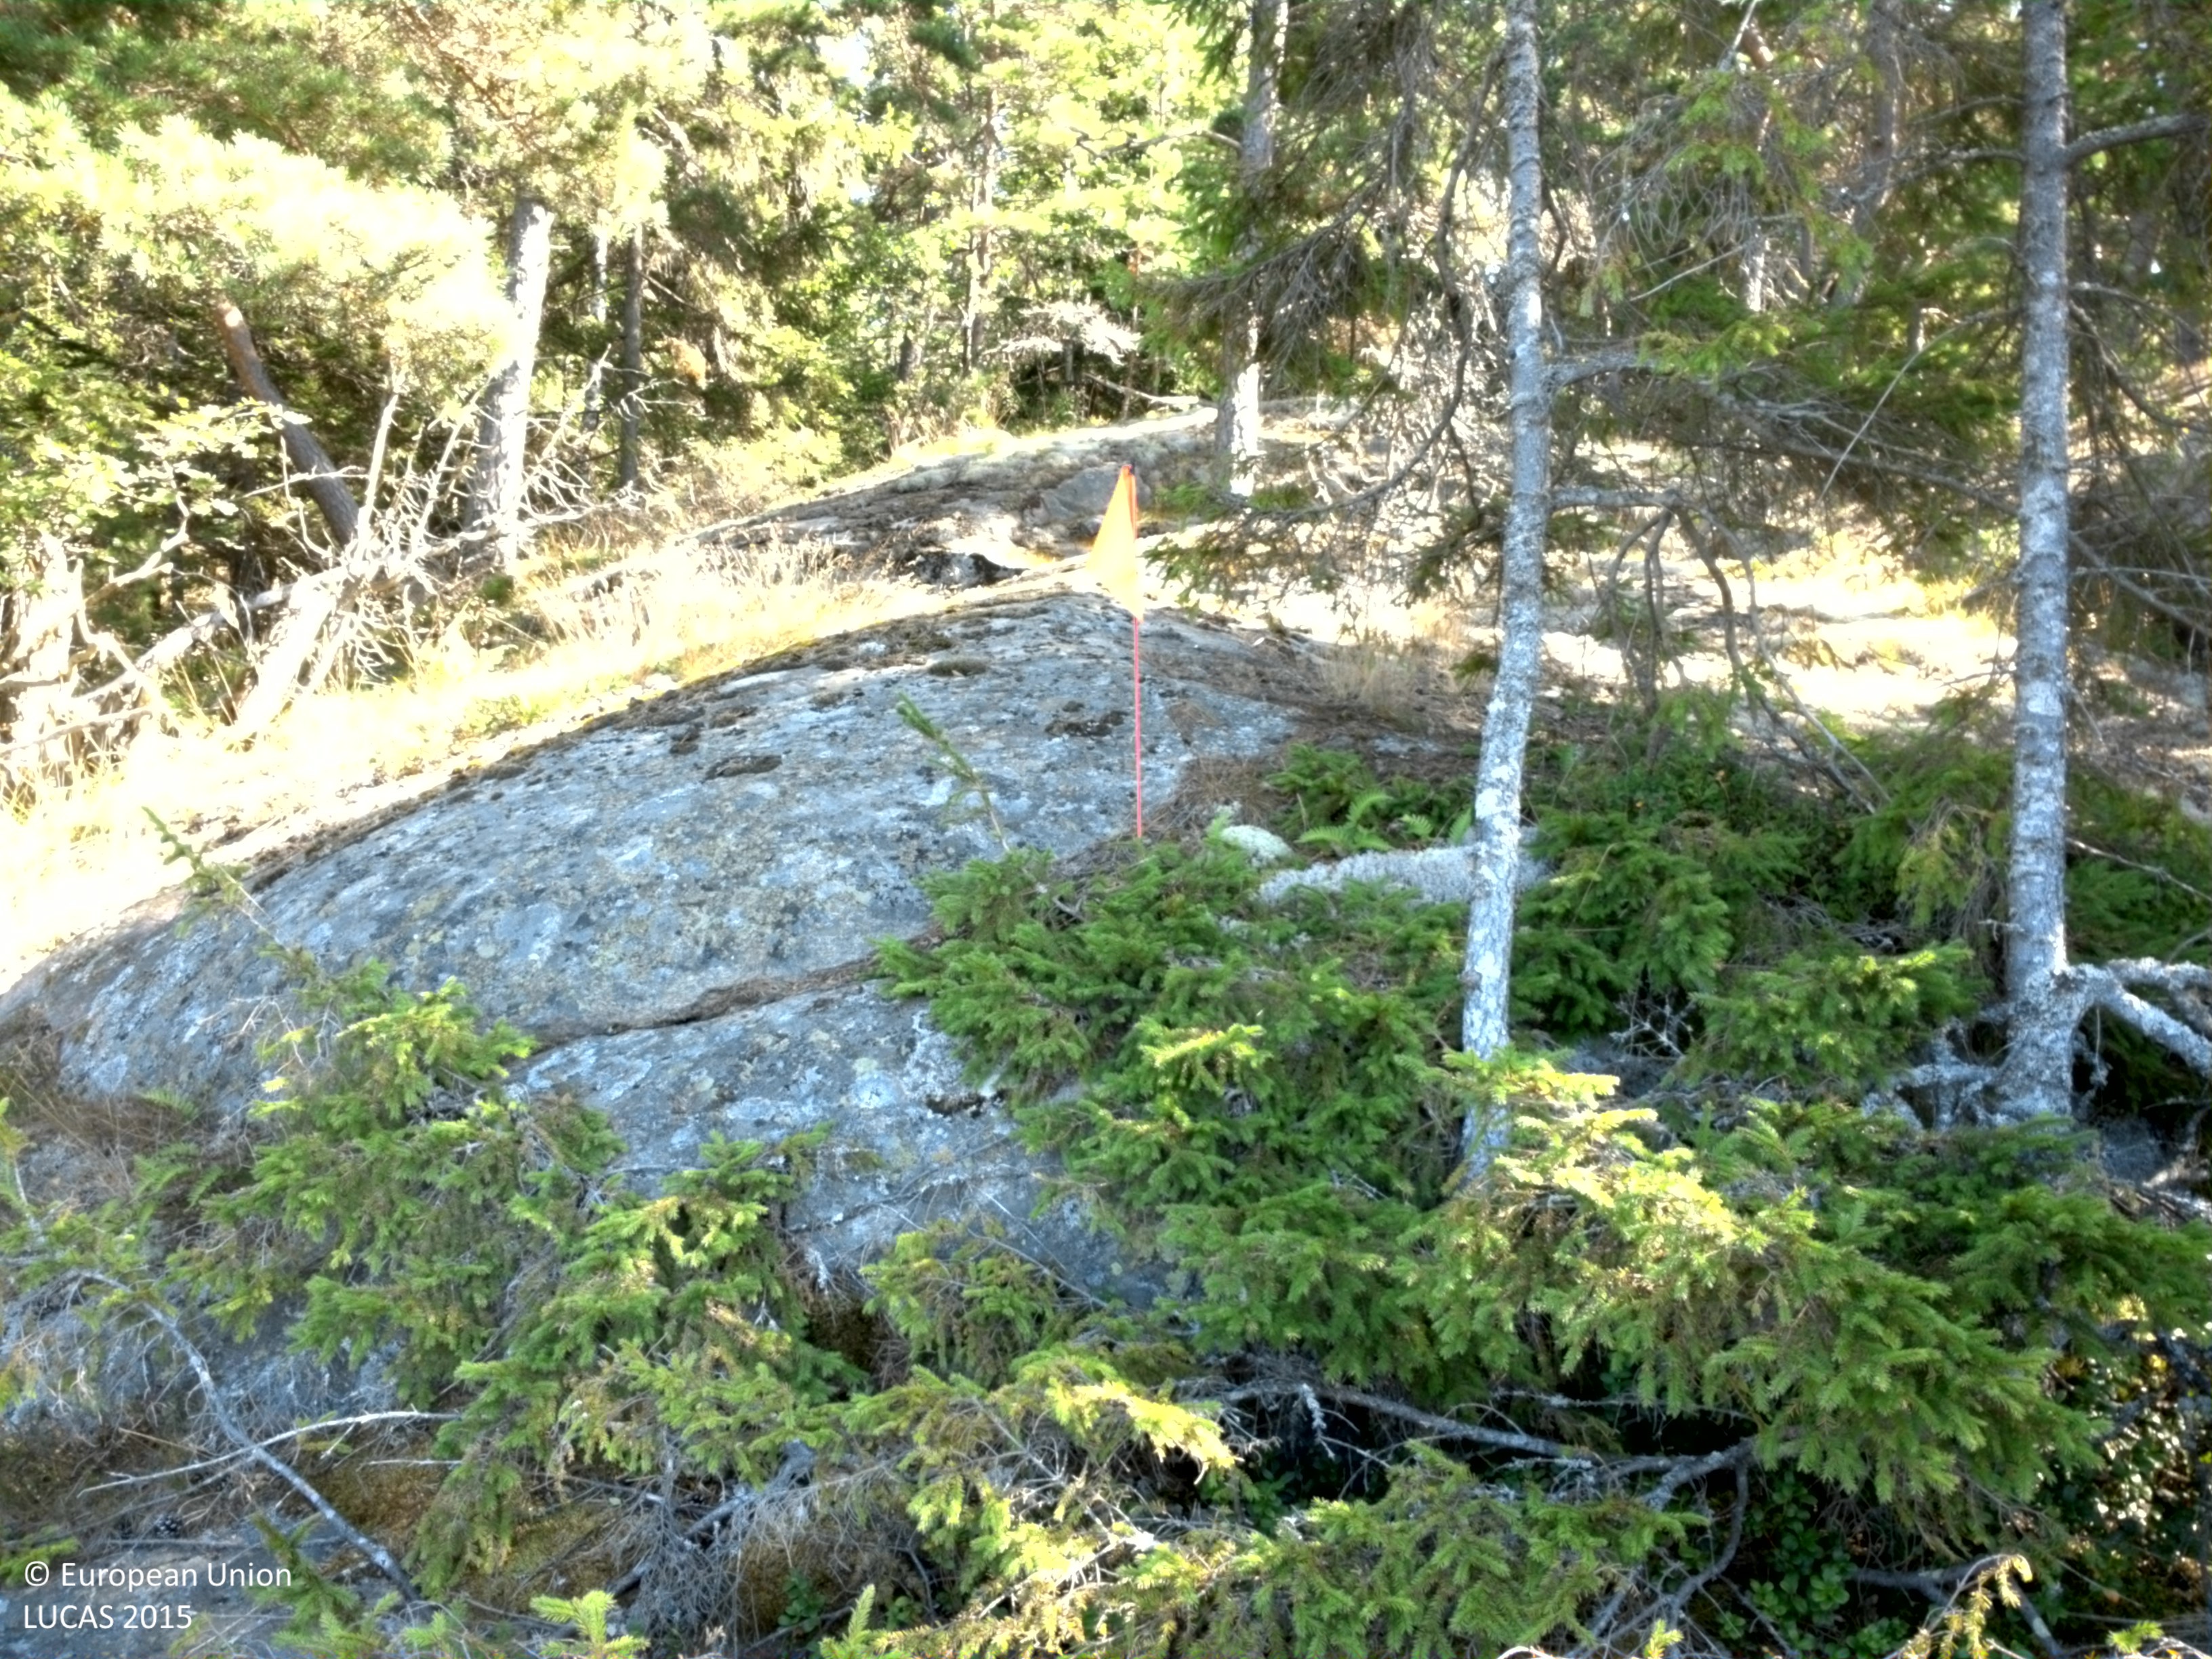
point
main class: Woodland
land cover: Other coniferous woodland
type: boreal forest
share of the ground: 50 - 75 %
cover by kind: coniferous forest trees 45 %, consolidated bare surface 30 %, lichens and mosses 20 %, broadleaved forest trees 5 %
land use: Forestry
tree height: > 5 m
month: August
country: SE
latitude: 59.5969
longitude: 18.8058
